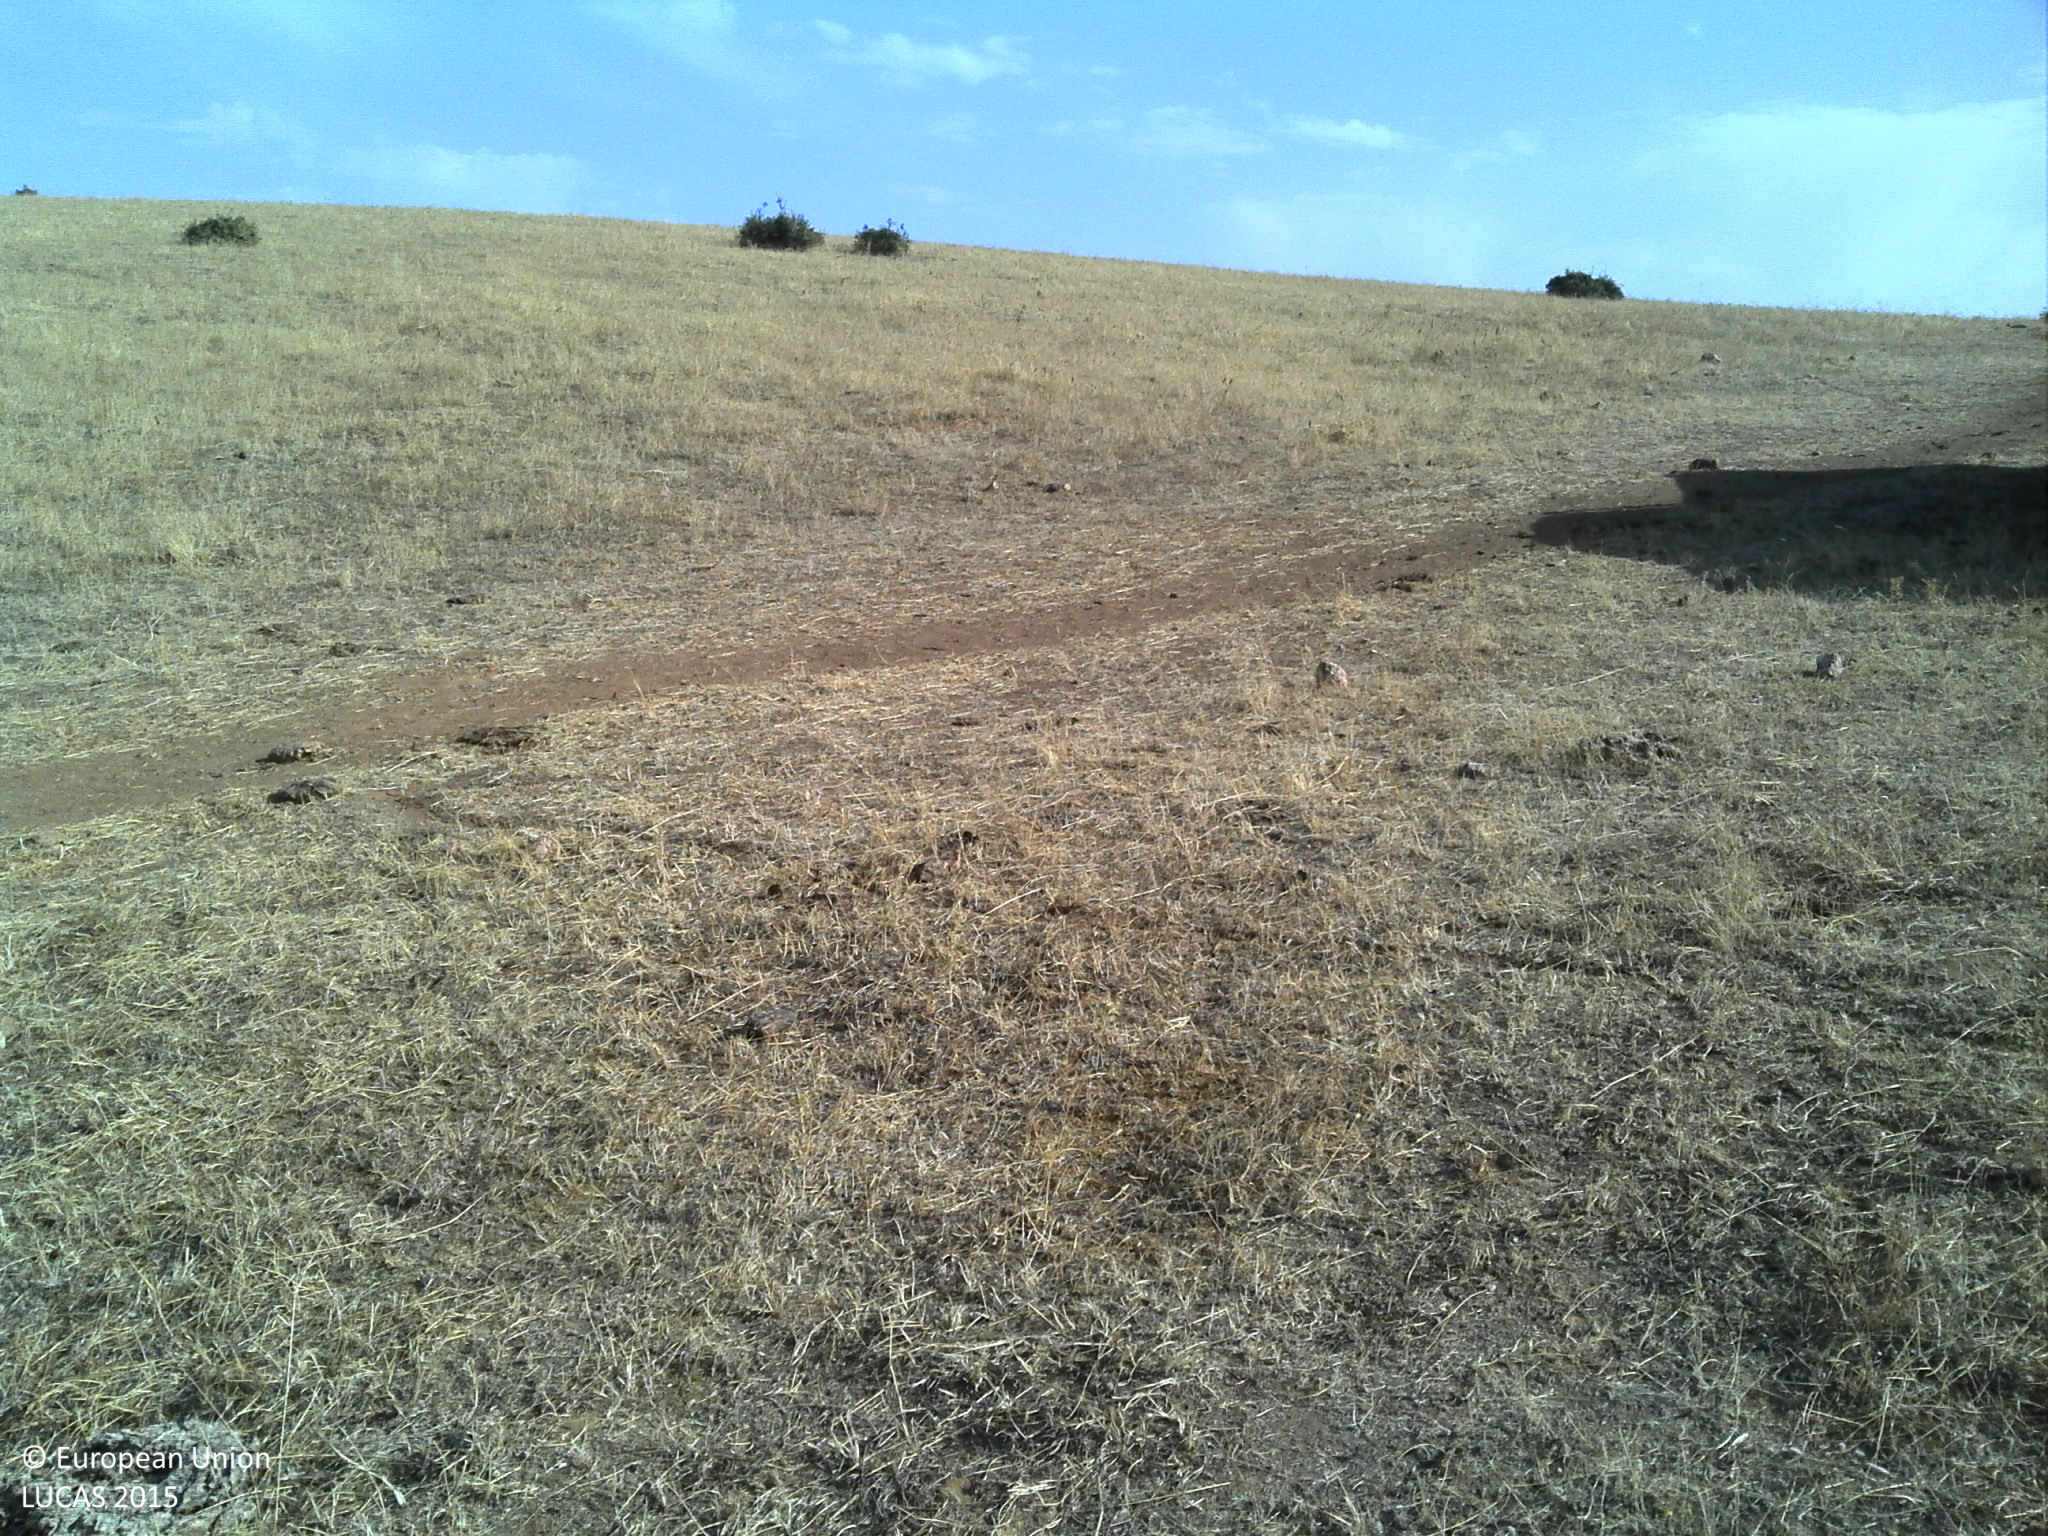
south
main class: Grassland
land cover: Grassland without tree/shrub cover
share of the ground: 10 - 25 %
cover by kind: unconsolidated bare surface 85 %, herbaceous plants 15 %
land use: Agriculture (excluding fallow land and kitchen gardens)
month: July
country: PT
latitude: 37.8292
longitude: -7.8036
